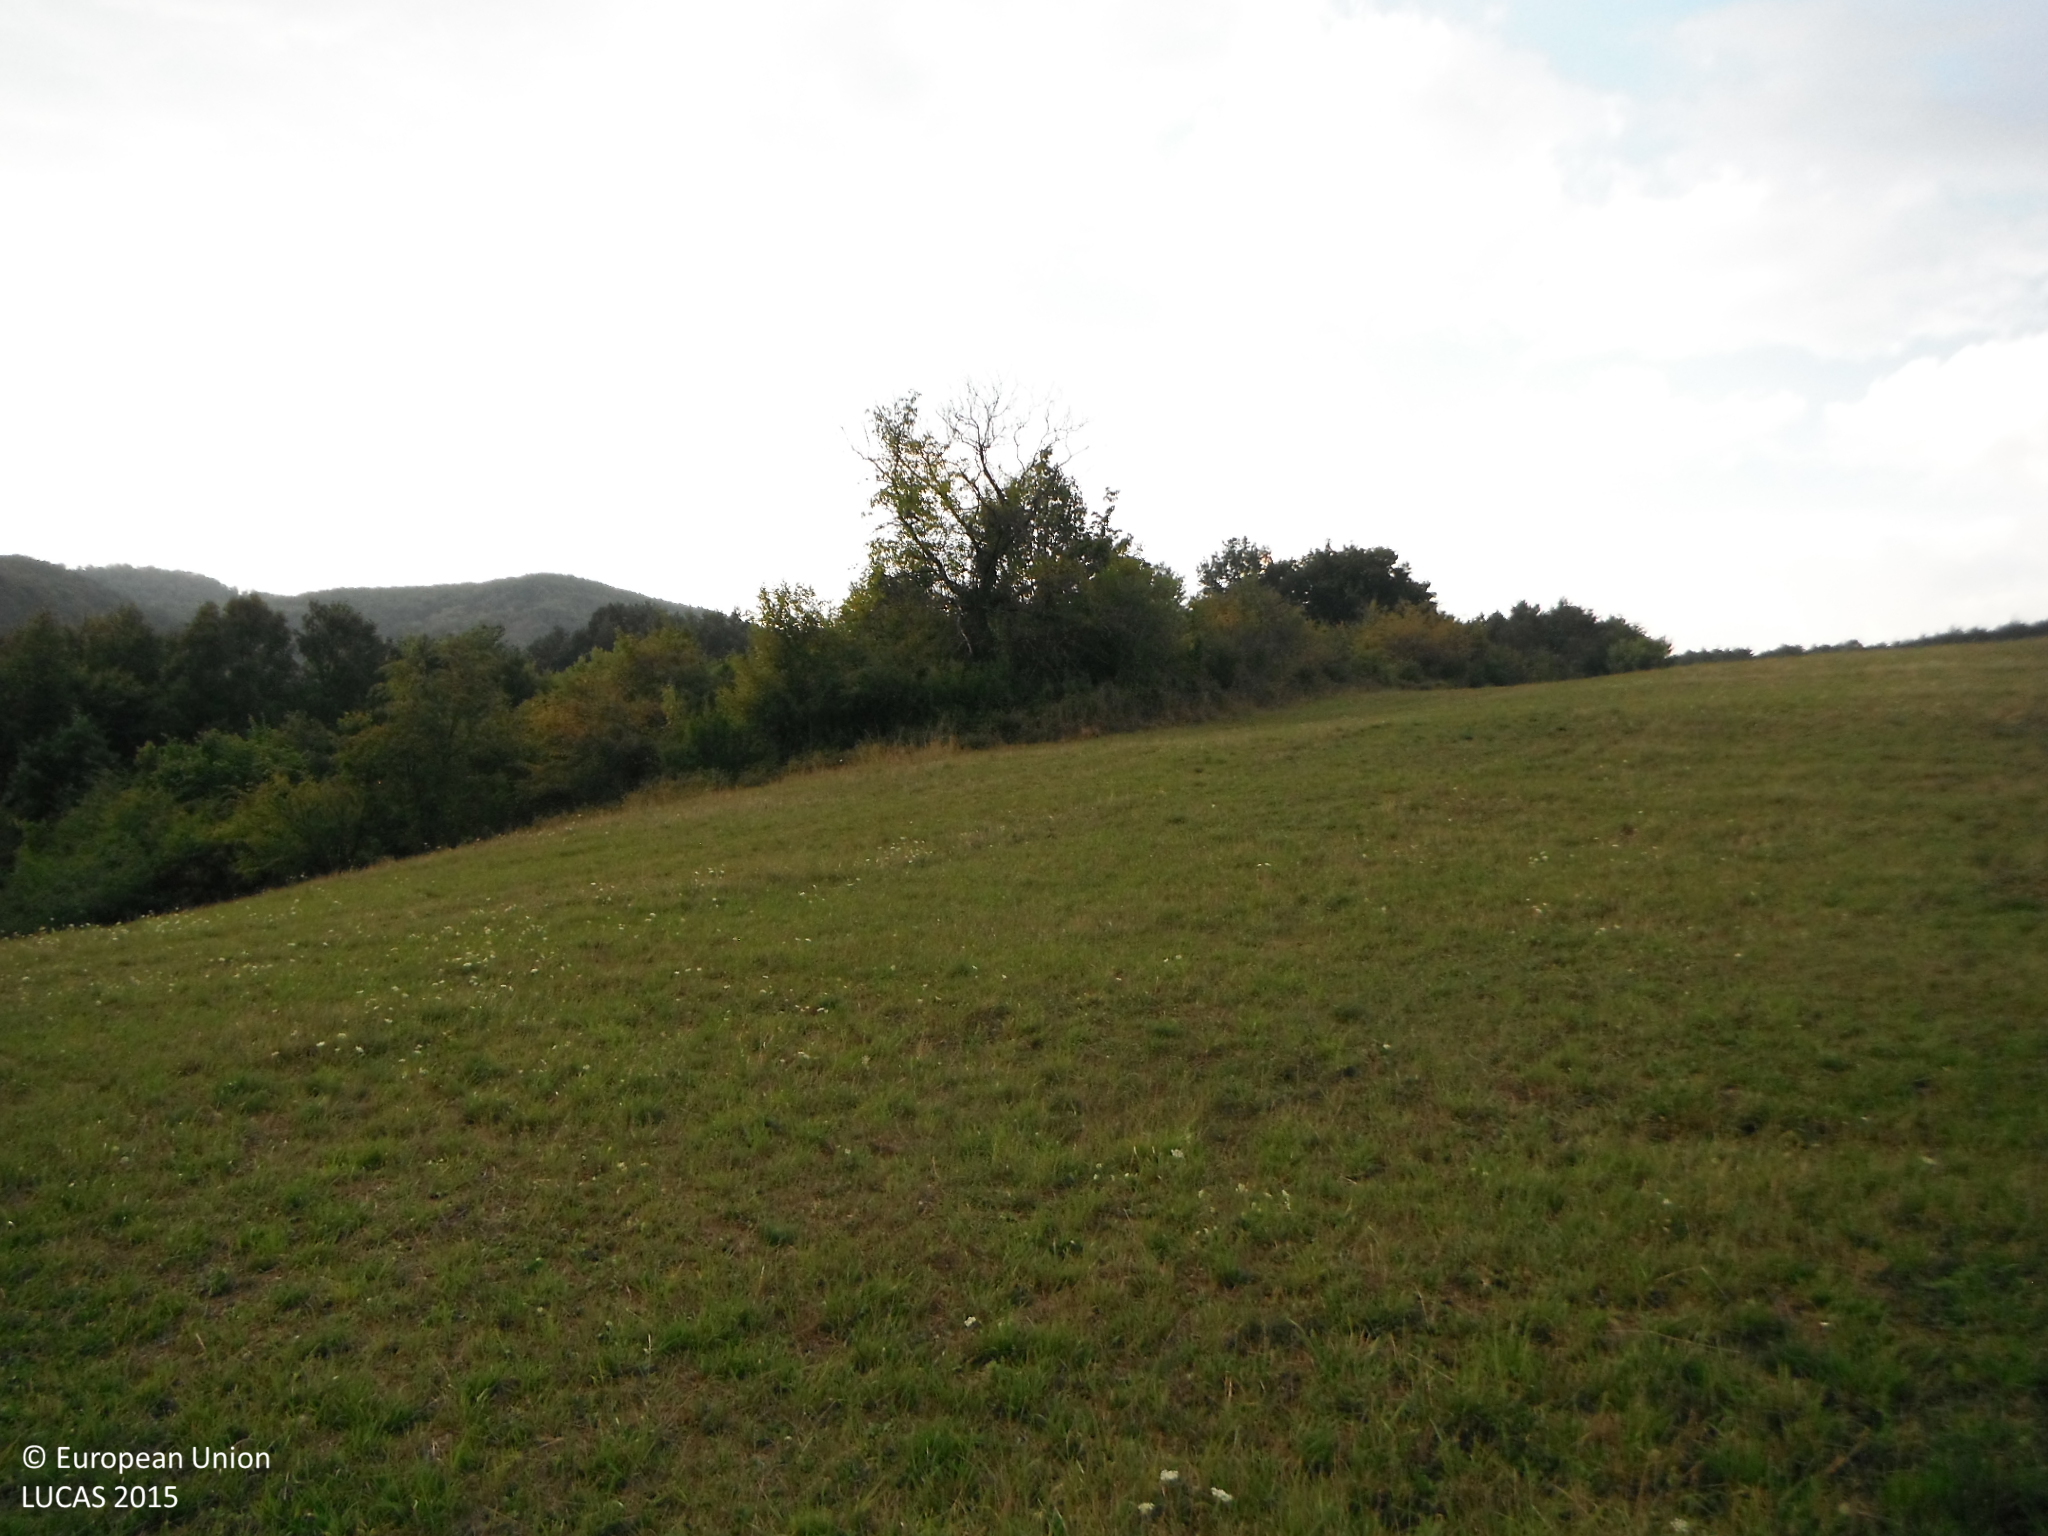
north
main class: Grassland
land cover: Grassland without tree/shrub cover
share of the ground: > 75 %
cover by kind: herbaceous plants 100 %
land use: Agriculture (excluding fallow land and kitchen gardens)
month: August
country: SK
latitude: 48.8117
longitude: 18.3366
